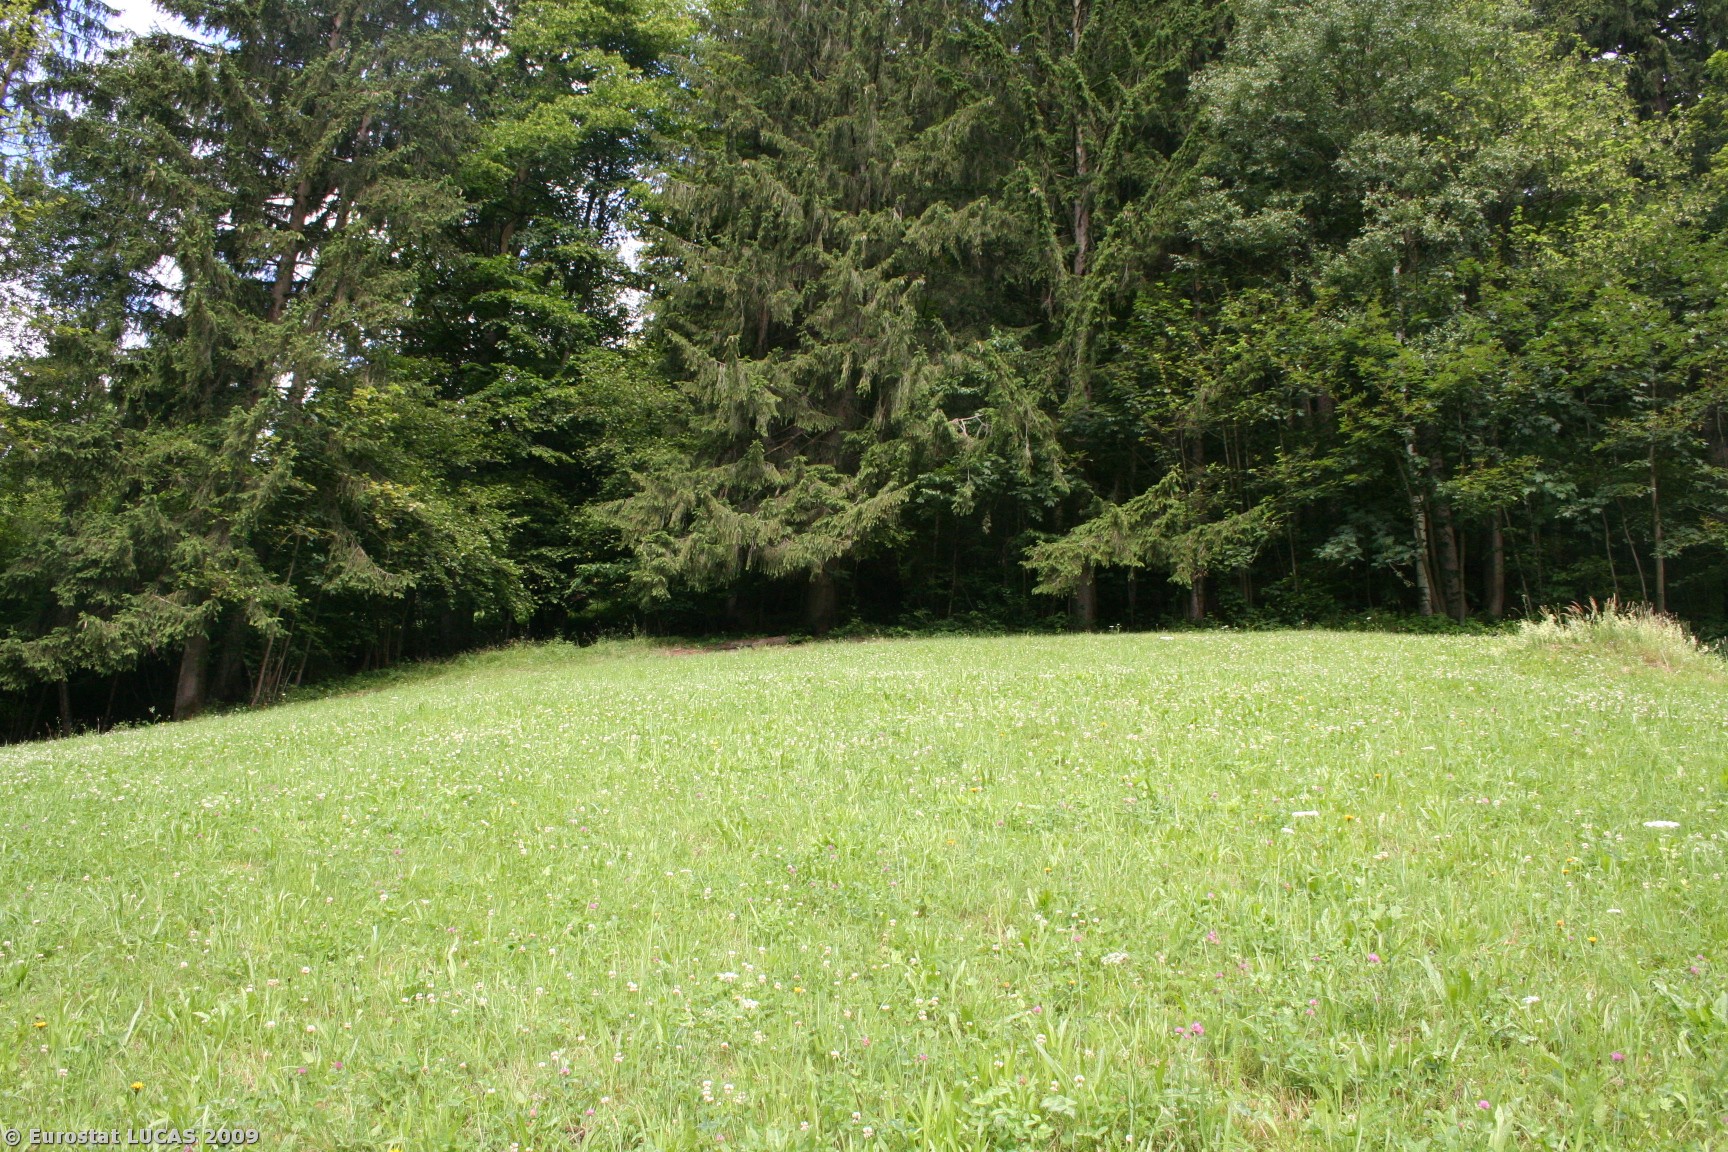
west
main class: Grassland
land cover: Grassland without tree/shrub cover
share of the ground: > 75 %
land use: Agriculture (excluding fallow land and kitchen gardens)
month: June
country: AT
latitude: 47.1996
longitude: 11.8596
